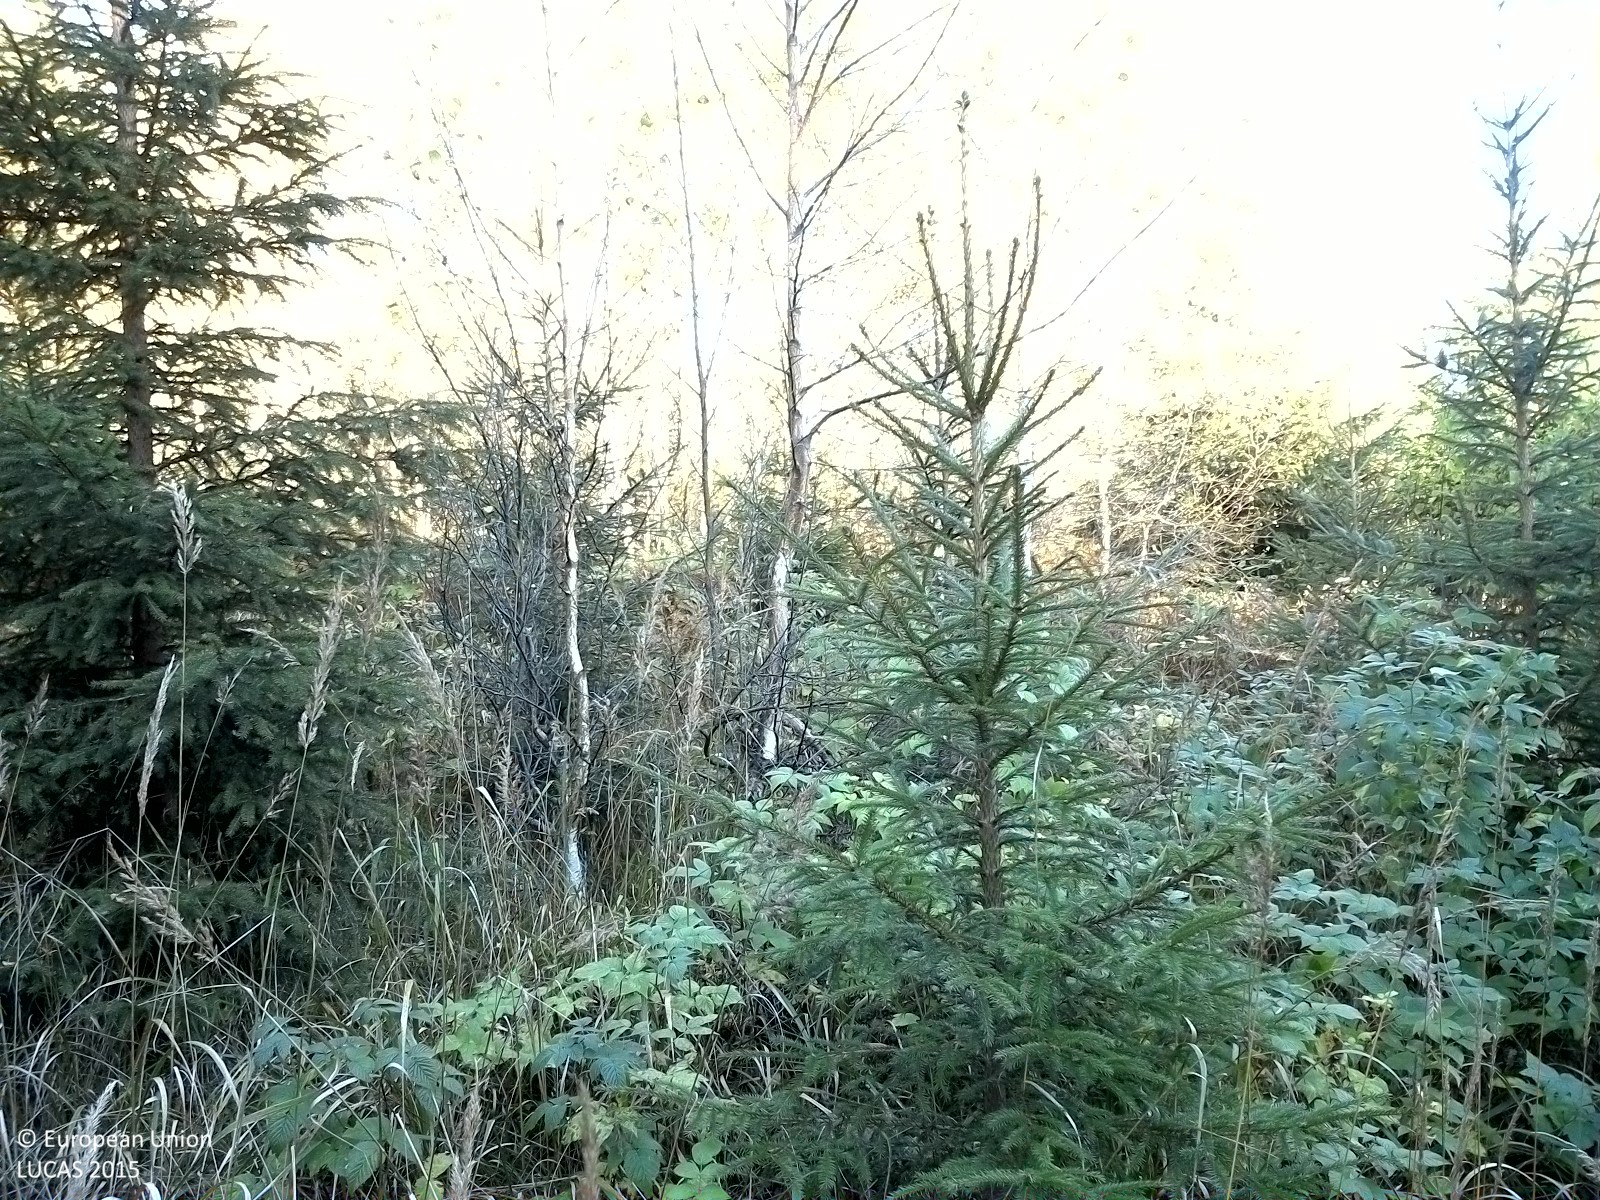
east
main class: Woodland
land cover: Spruce dominated coniferous woodland
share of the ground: 25 - 50 %
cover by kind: herbaceous plants 70 %, coniferous forest trees 25 %, broadleaved forest trees 5 %
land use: Forestry
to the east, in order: Spruce dominated coniferous woodland; Spruce dominated mixed woodland; Other mixed woodland; Spruce dominated mixed woodland; Spruce dominated coniferous woodland; Spruce dominated mixed woodland
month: September
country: SE
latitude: 62.6531
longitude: 16.9055
